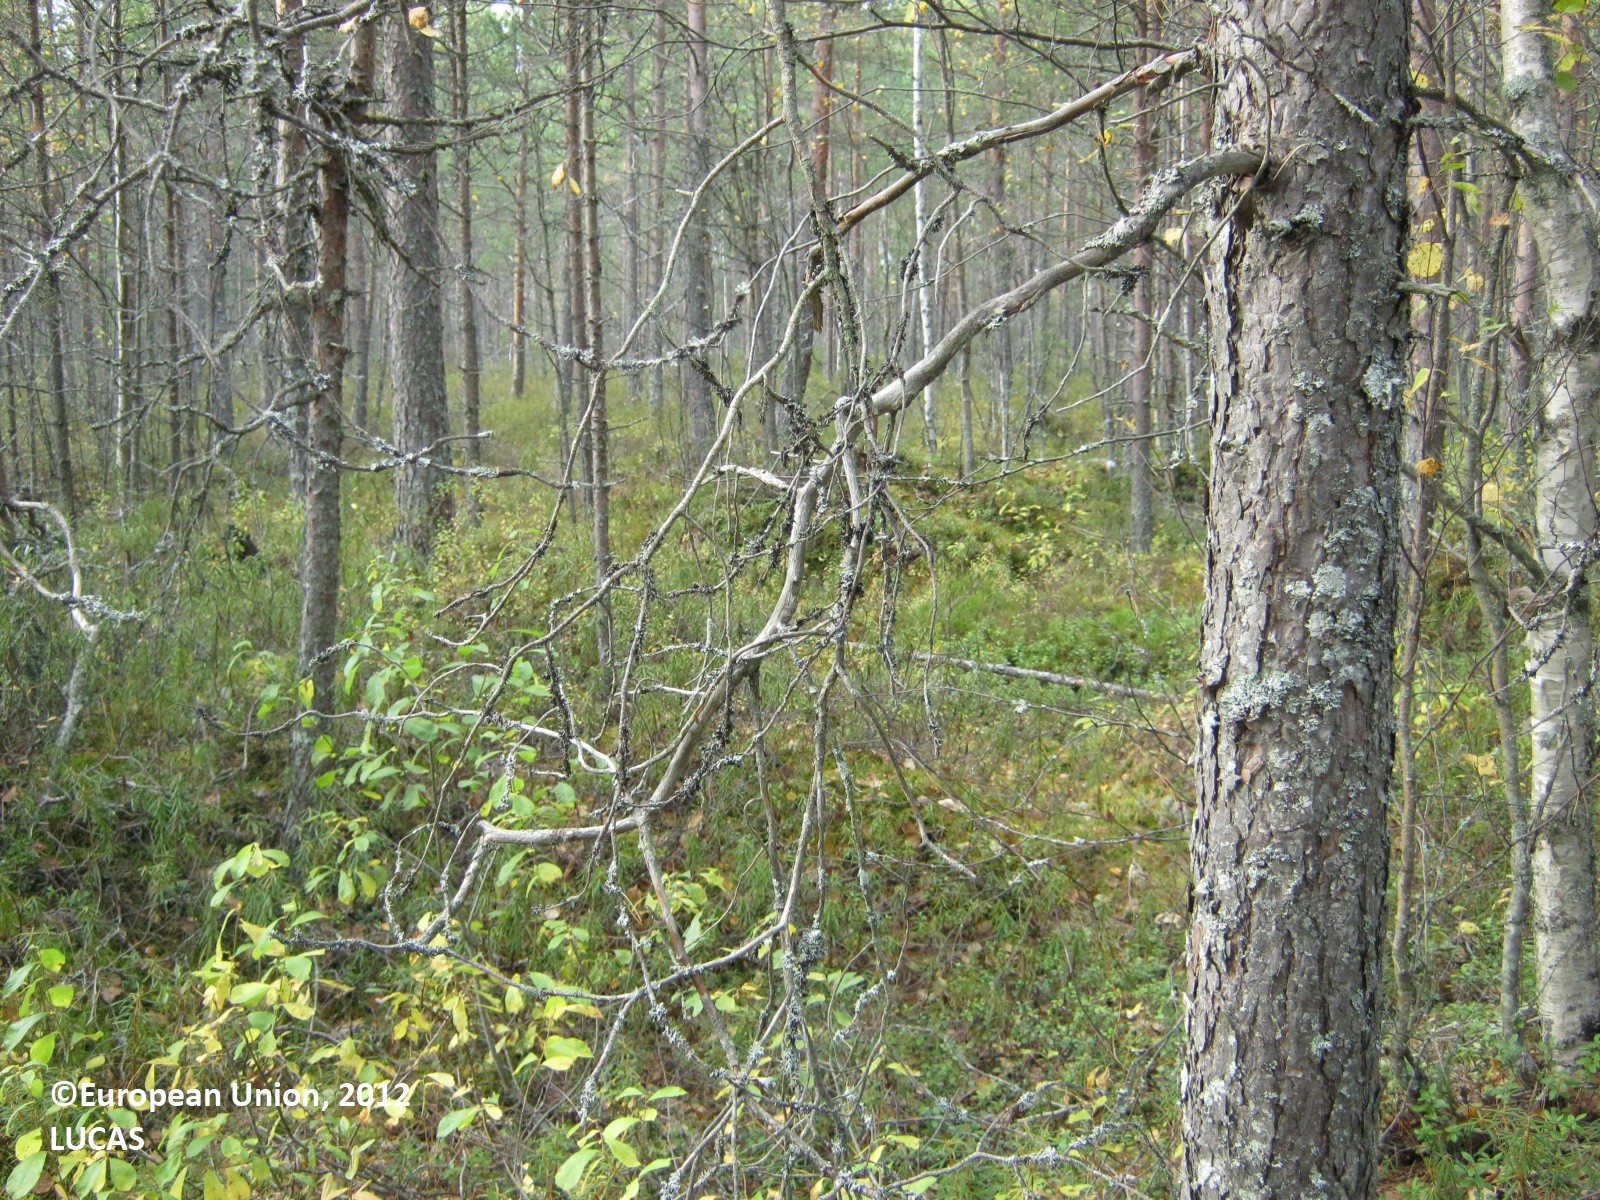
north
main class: Woodland
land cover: Pine dominated coniferous woodland
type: boreal forest
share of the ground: > 75 %
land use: Forestry
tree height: > 5 m
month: September
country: FI
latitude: 63.4985
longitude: 25.8786
